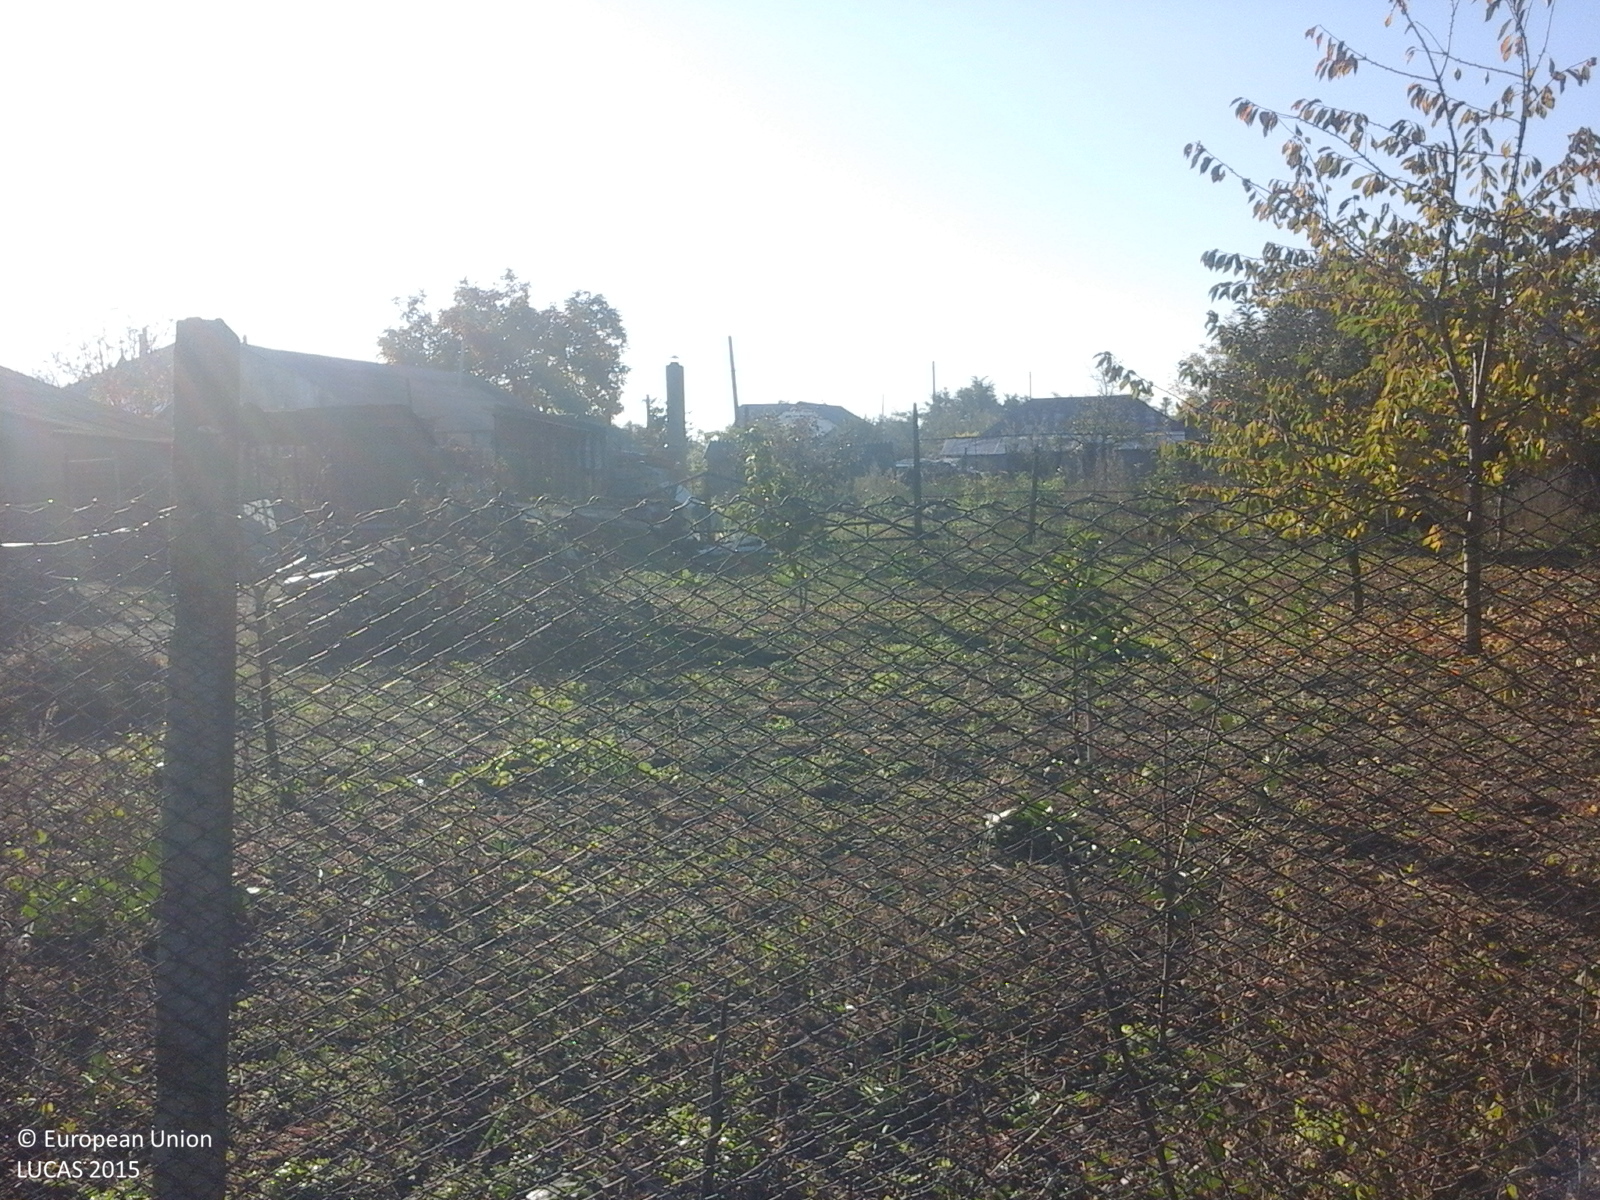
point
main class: Cropland
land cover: Nuts trees
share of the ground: 50 - 75 %
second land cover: Grassland without tree/shrub cover
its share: 25 - 50 %
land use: Agriculture (excluding fallow land and kitchen gardens)
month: October
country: RO
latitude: 45.9185
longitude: 27.2070
